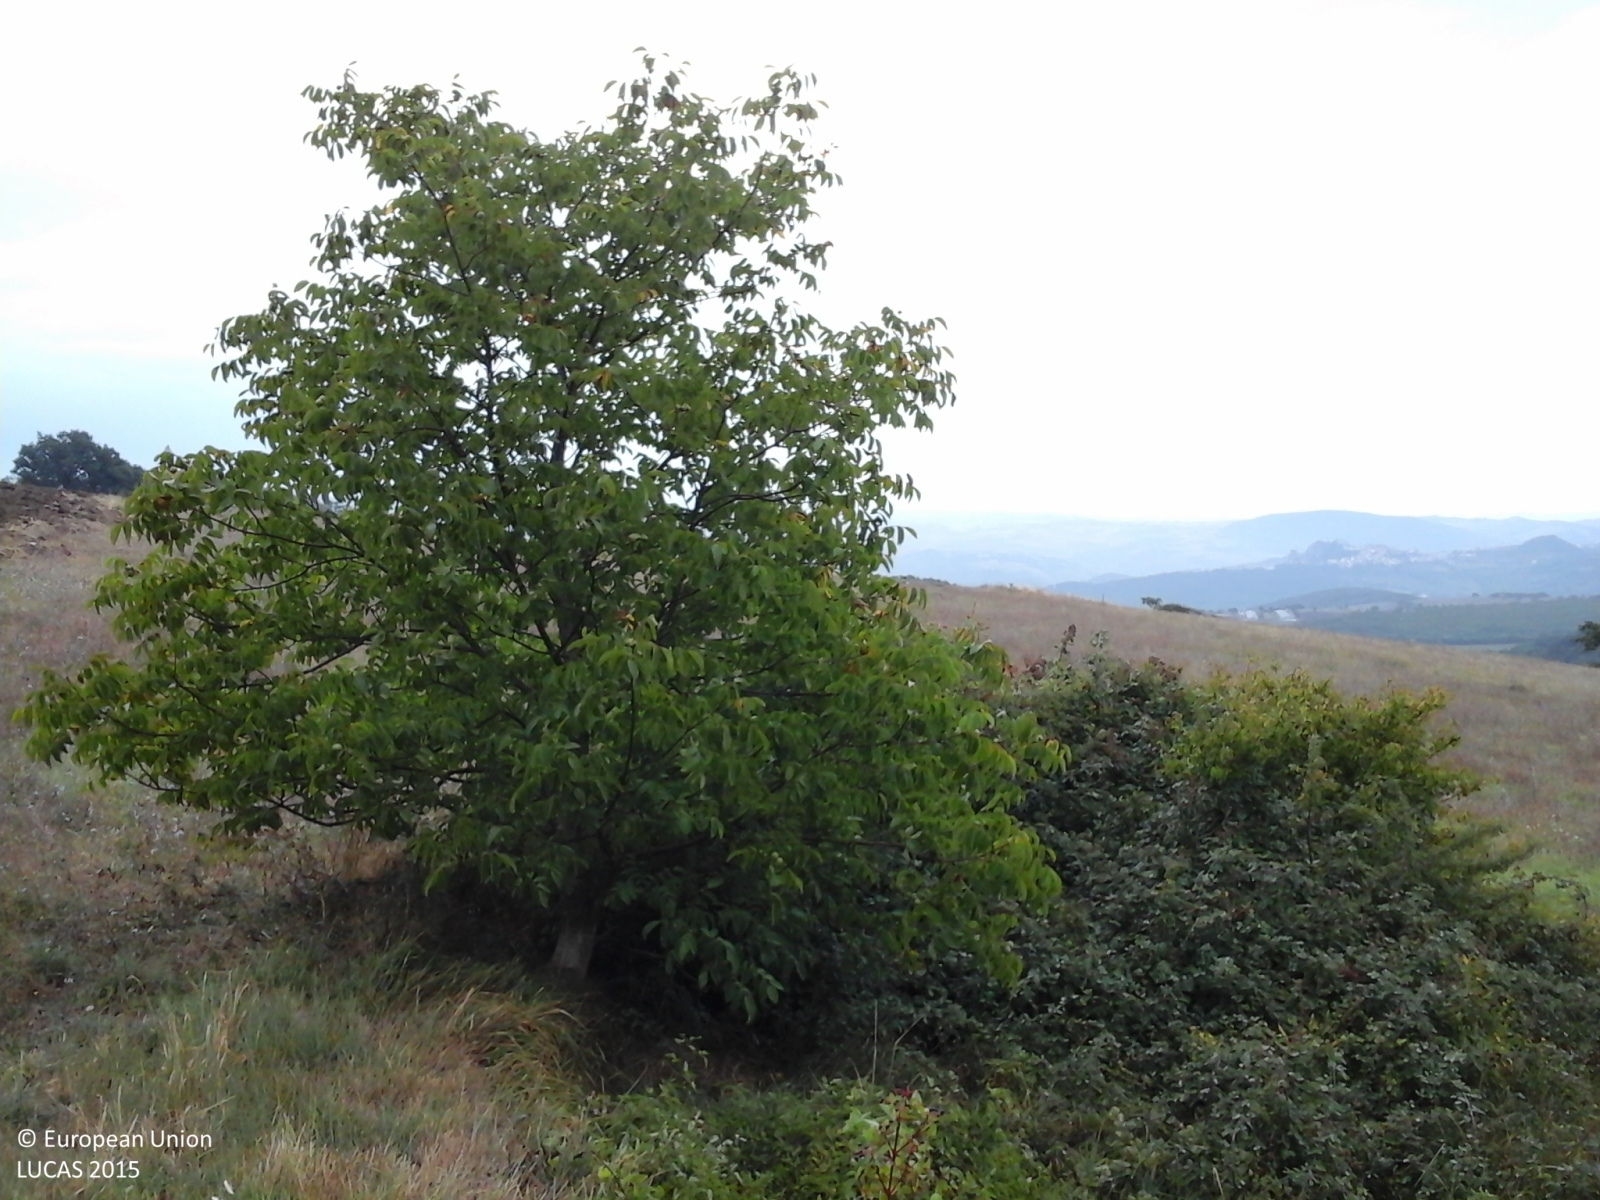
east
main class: Cropland
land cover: Temporary grasslands
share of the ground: > 75 %
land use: Agriculture (excluding fallow land and kitchen gardens)
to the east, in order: Temporary grasslands; Shrubland with sparse tree cover; Temporary grasslands; Abandoned hedges; Temporary grasslands
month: September
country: IT
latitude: 41.7264
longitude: 14.3968
